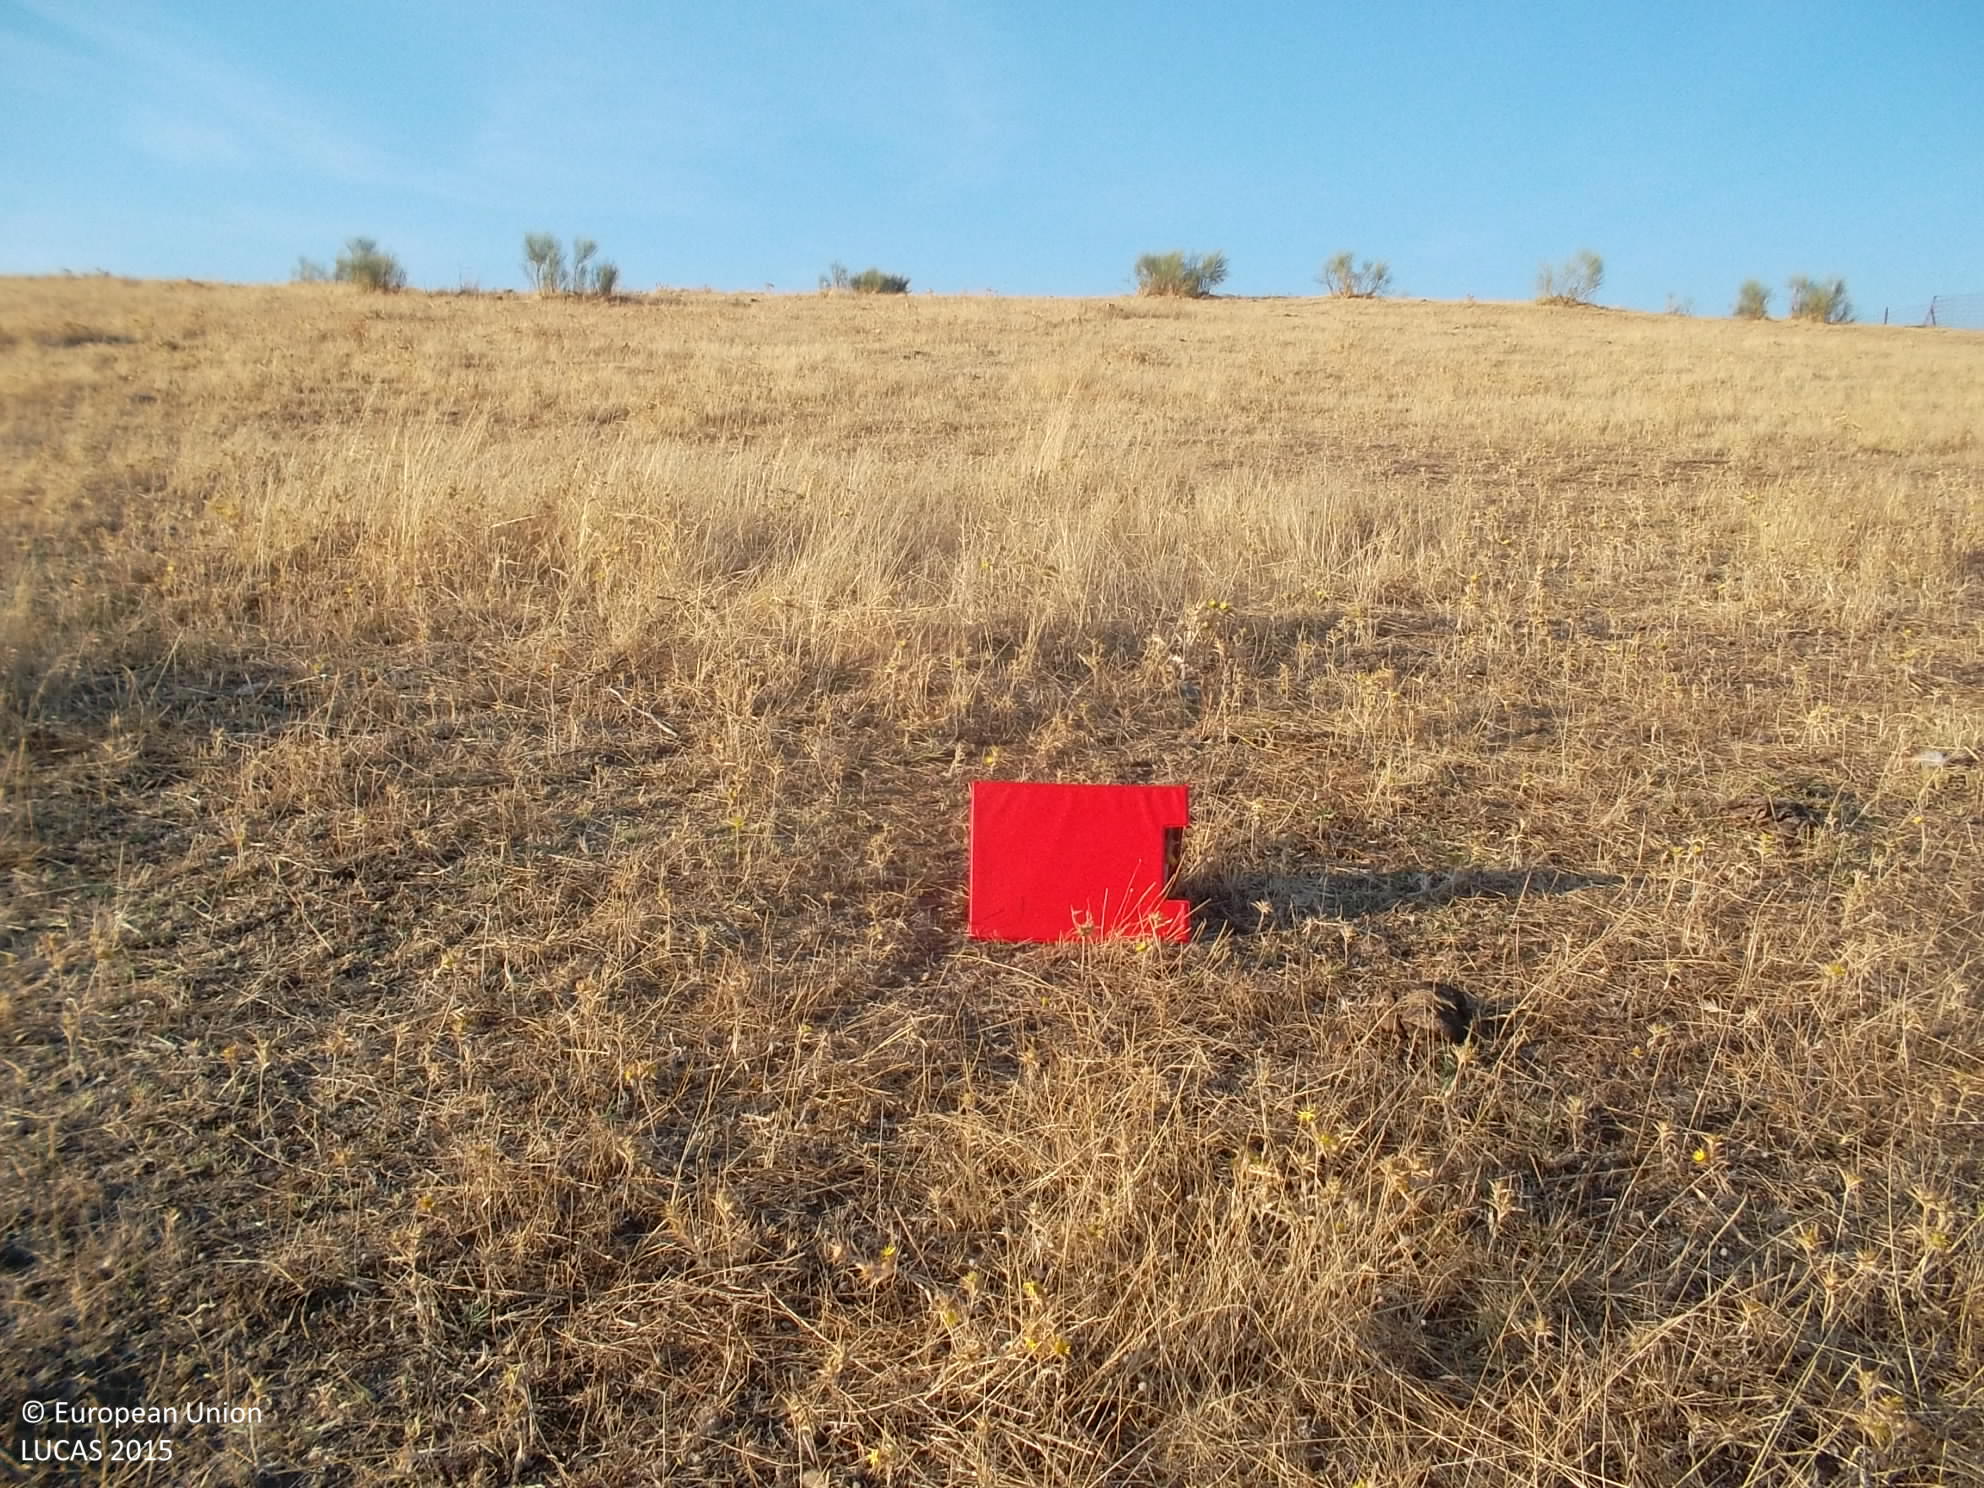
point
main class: Grassland
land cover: Grassland without tree/shrub cover
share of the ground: > 75 %
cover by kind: herbaceous plants 100 %
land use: Agriculture (excluding fallow land and kitchen gardens)
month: September
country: ES
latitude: 38.1558
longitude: -6.3058
